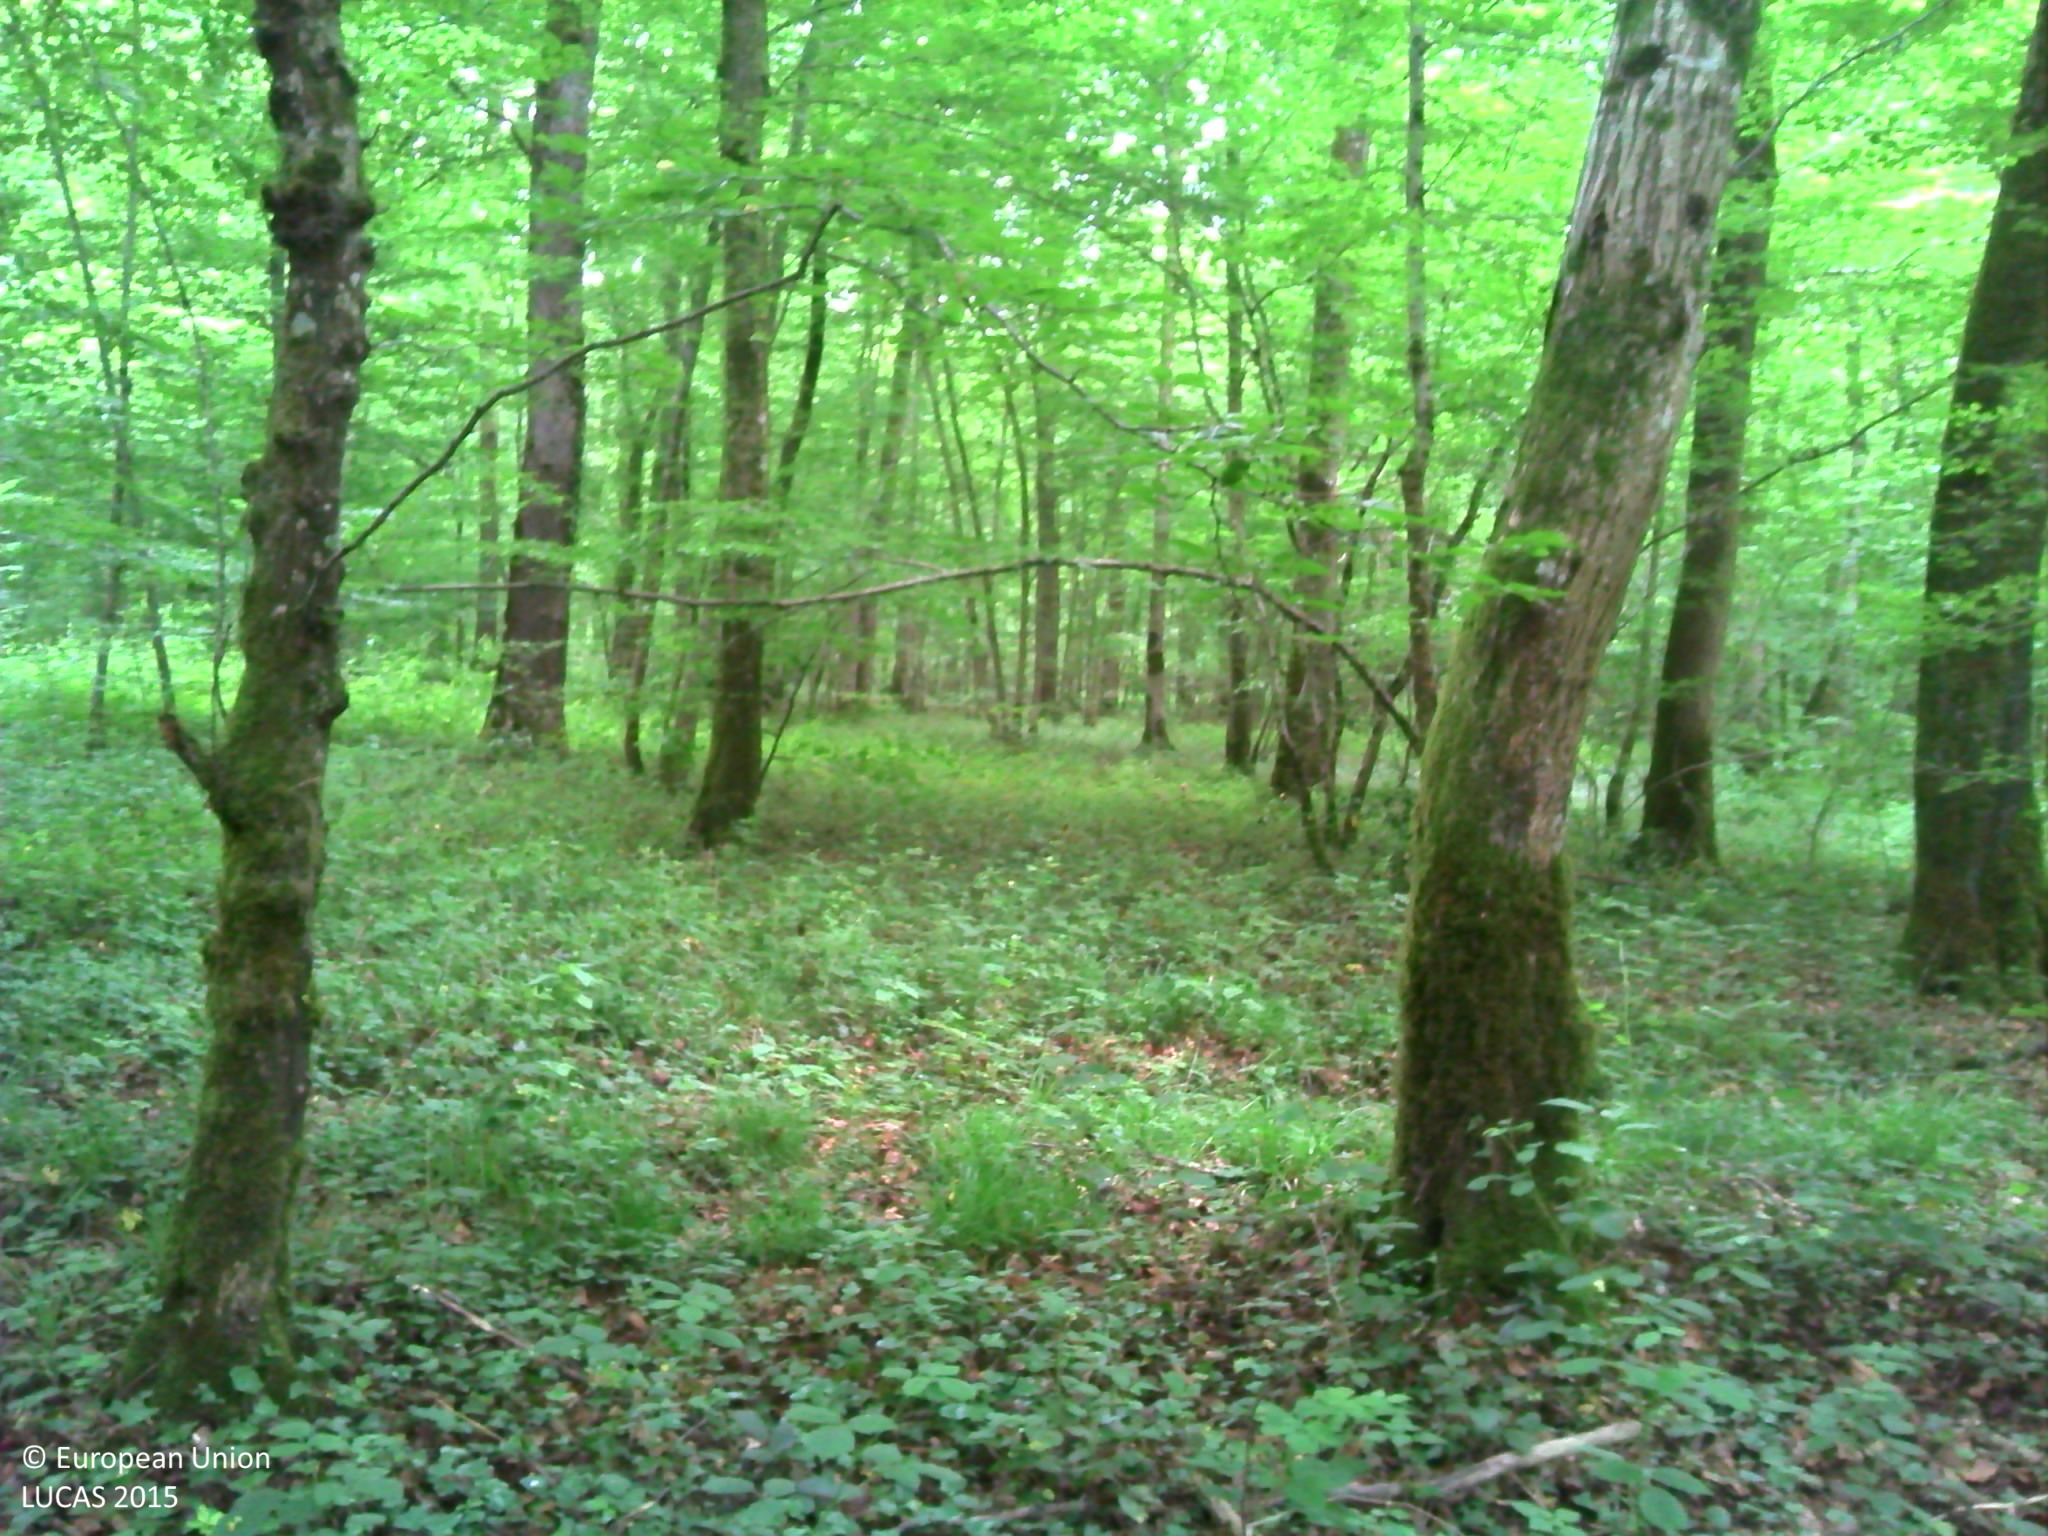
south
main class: Woodland
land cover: Broadleaved woodland
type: beech forest
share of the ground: > 75 %
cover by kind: broadleaved forest trees 95 %, herbaceous plants 5 %
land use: Forestry
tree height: > 5 m
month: June
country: FR
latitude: 47.5685
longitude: 6.3460
